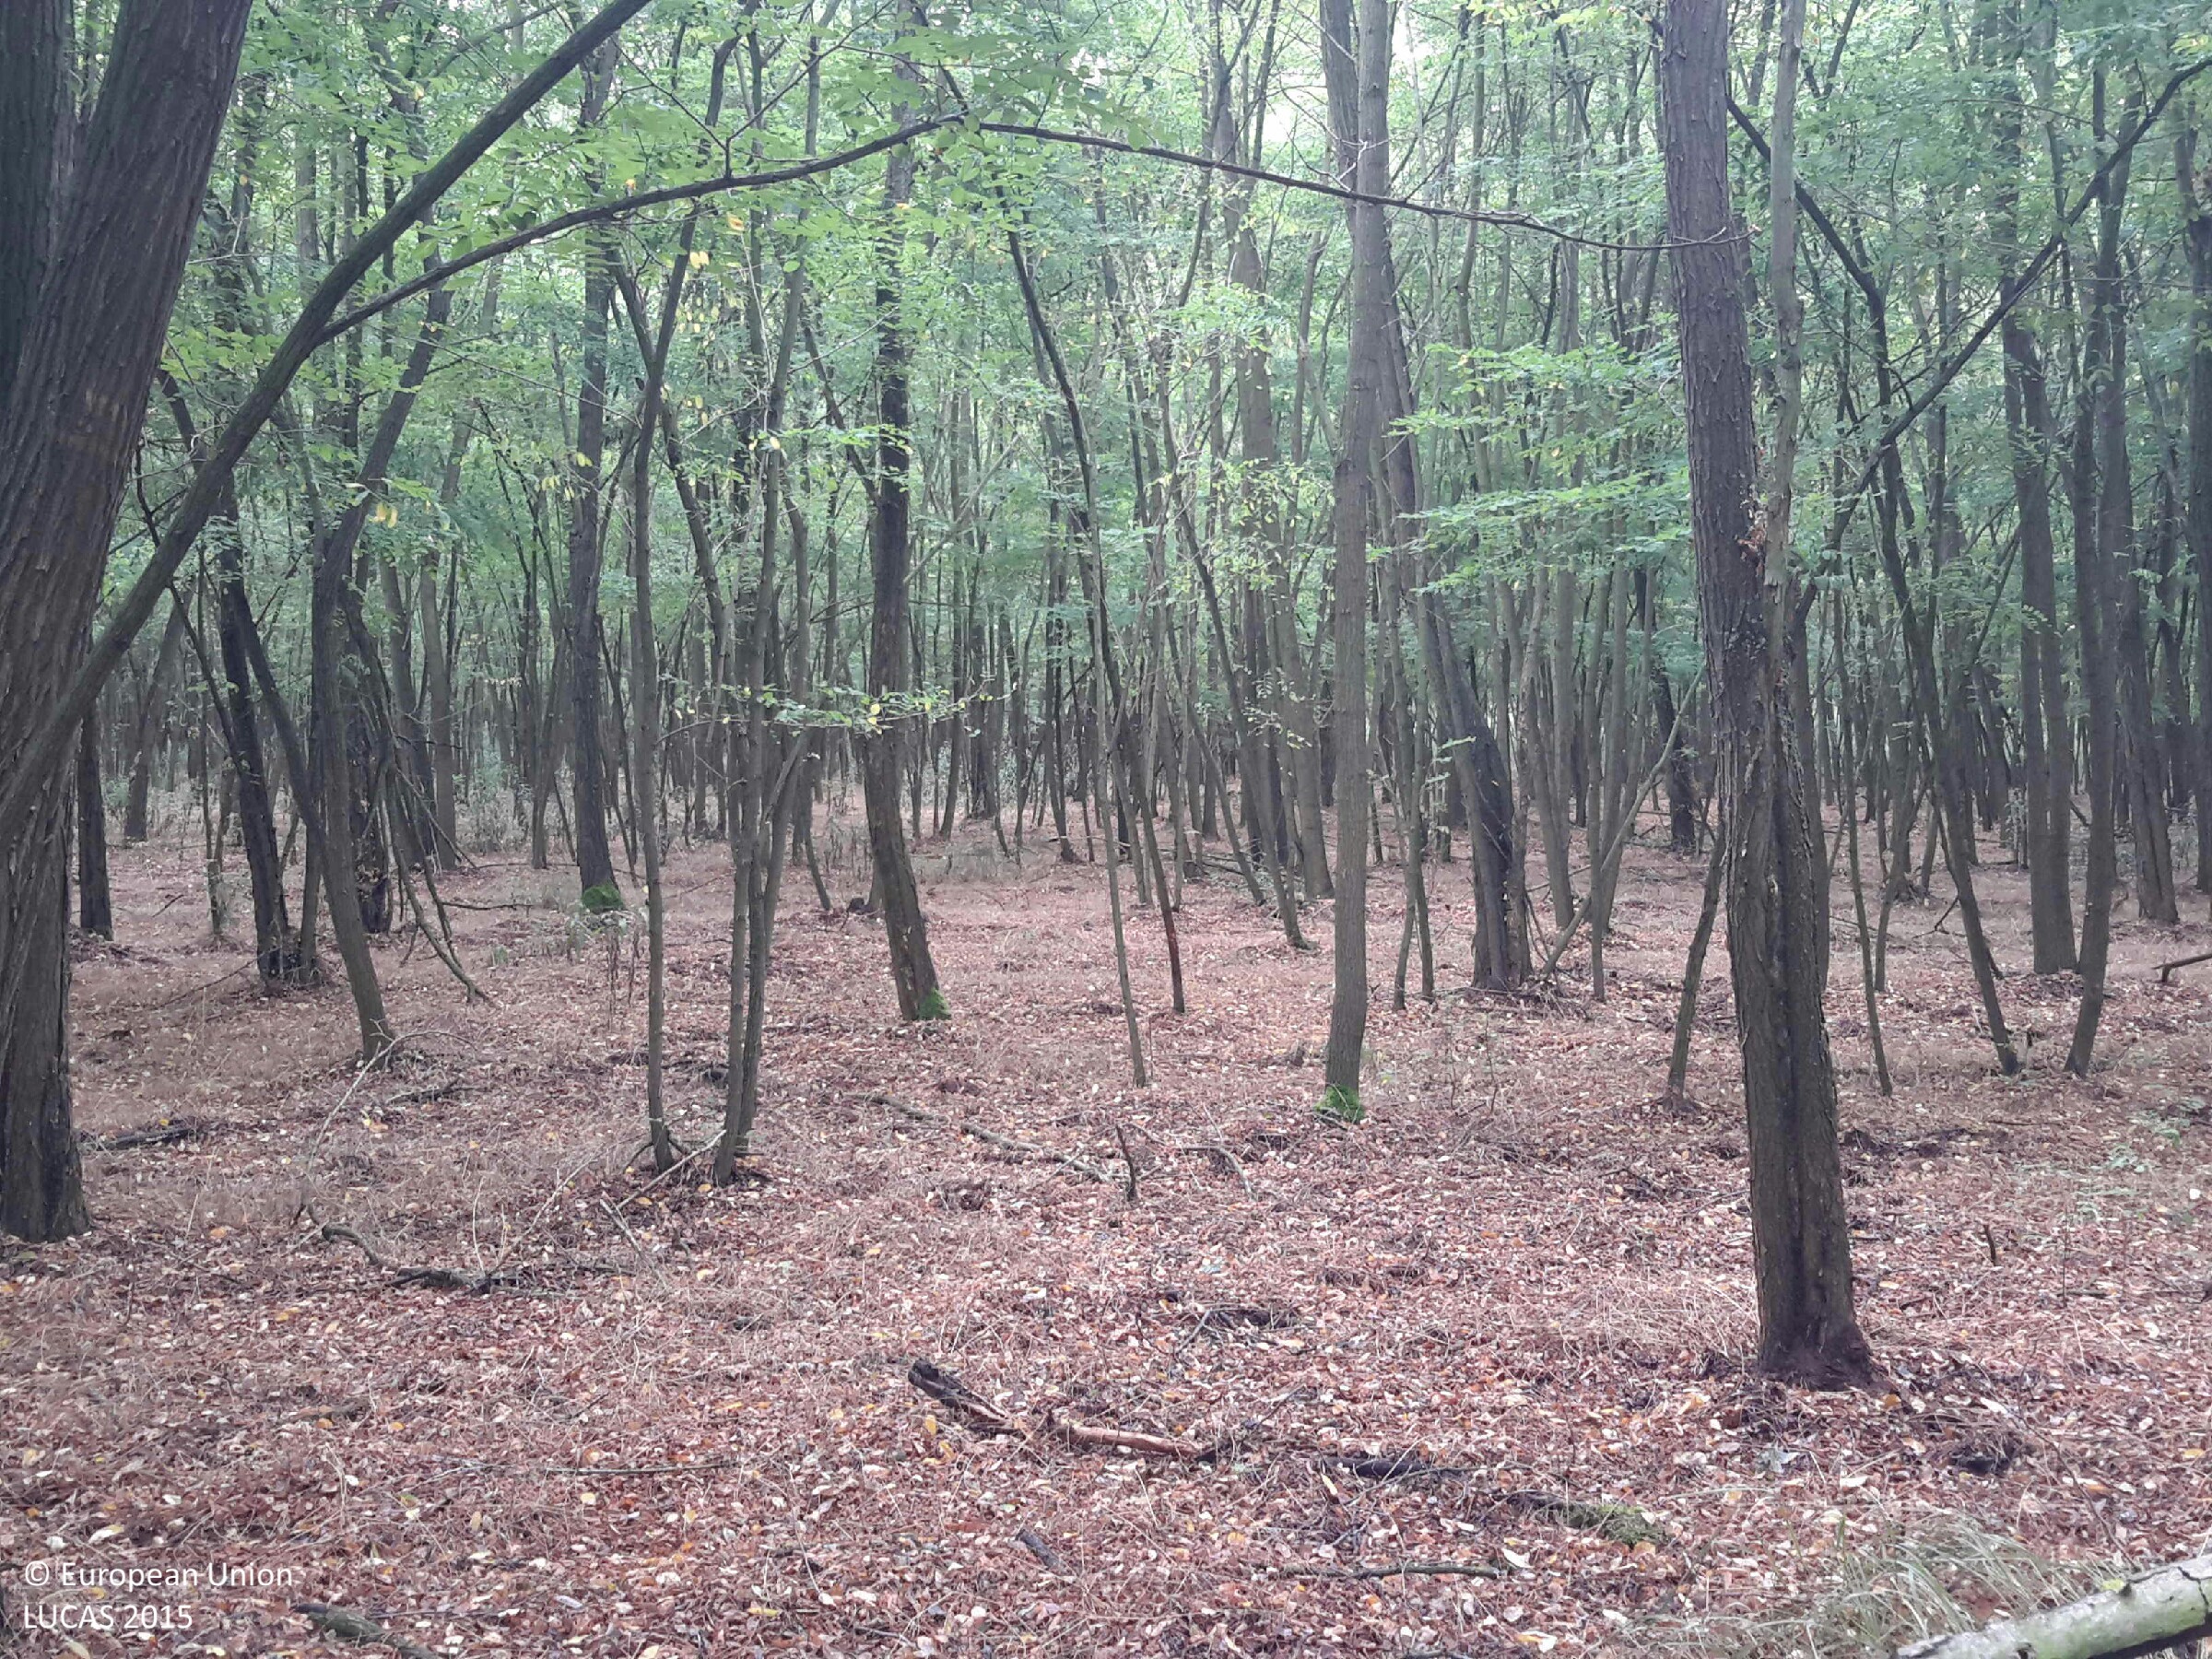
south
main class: Woodland
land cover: Broadleaved woodland
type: exotic forest
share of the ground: > 75 %
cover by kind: broadleaved forest trees 90 %, coniferous forest trees 5 %, unconsolidated bare surface 5 %
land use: Forestry
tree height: > 5 m
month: July
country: HU
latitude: 47.5690
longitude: 17.5187
